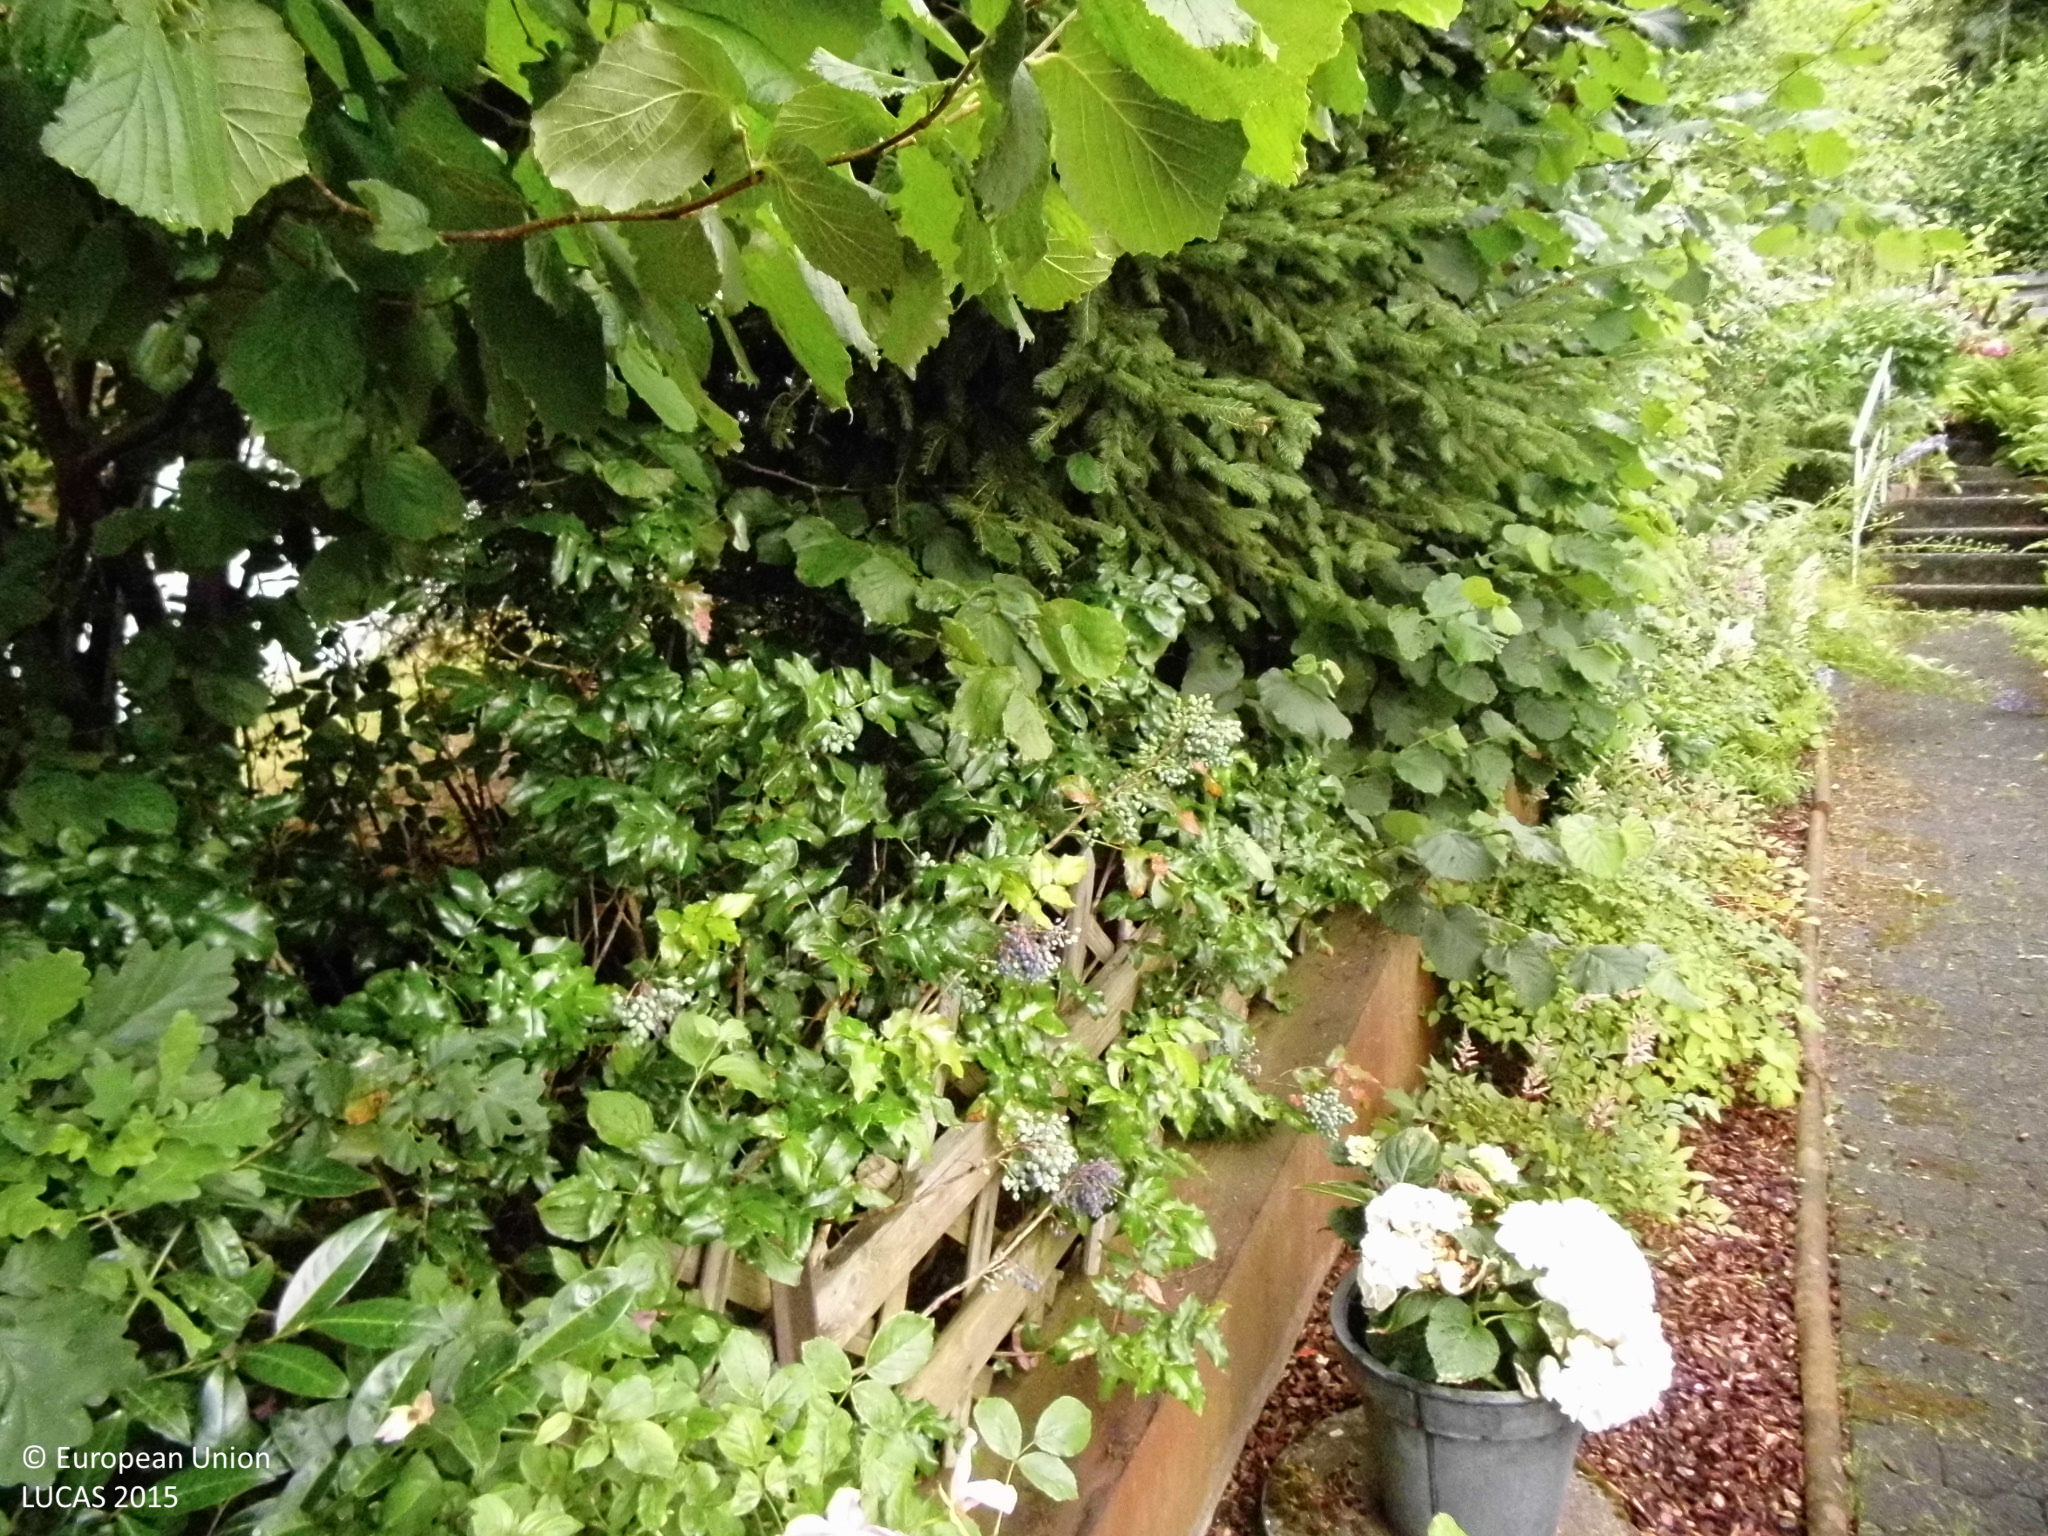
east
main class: Woodland
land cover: Broadleaved woodland
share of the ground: > 75 %
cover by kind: broadleaved forest trees 80 %, coniferous forest trees 20 %
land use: Residential
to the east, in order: Broadleaved woodland; Artificial constructions in urban areas
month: July
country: DE
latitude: 50.8322
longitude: 7.9984
